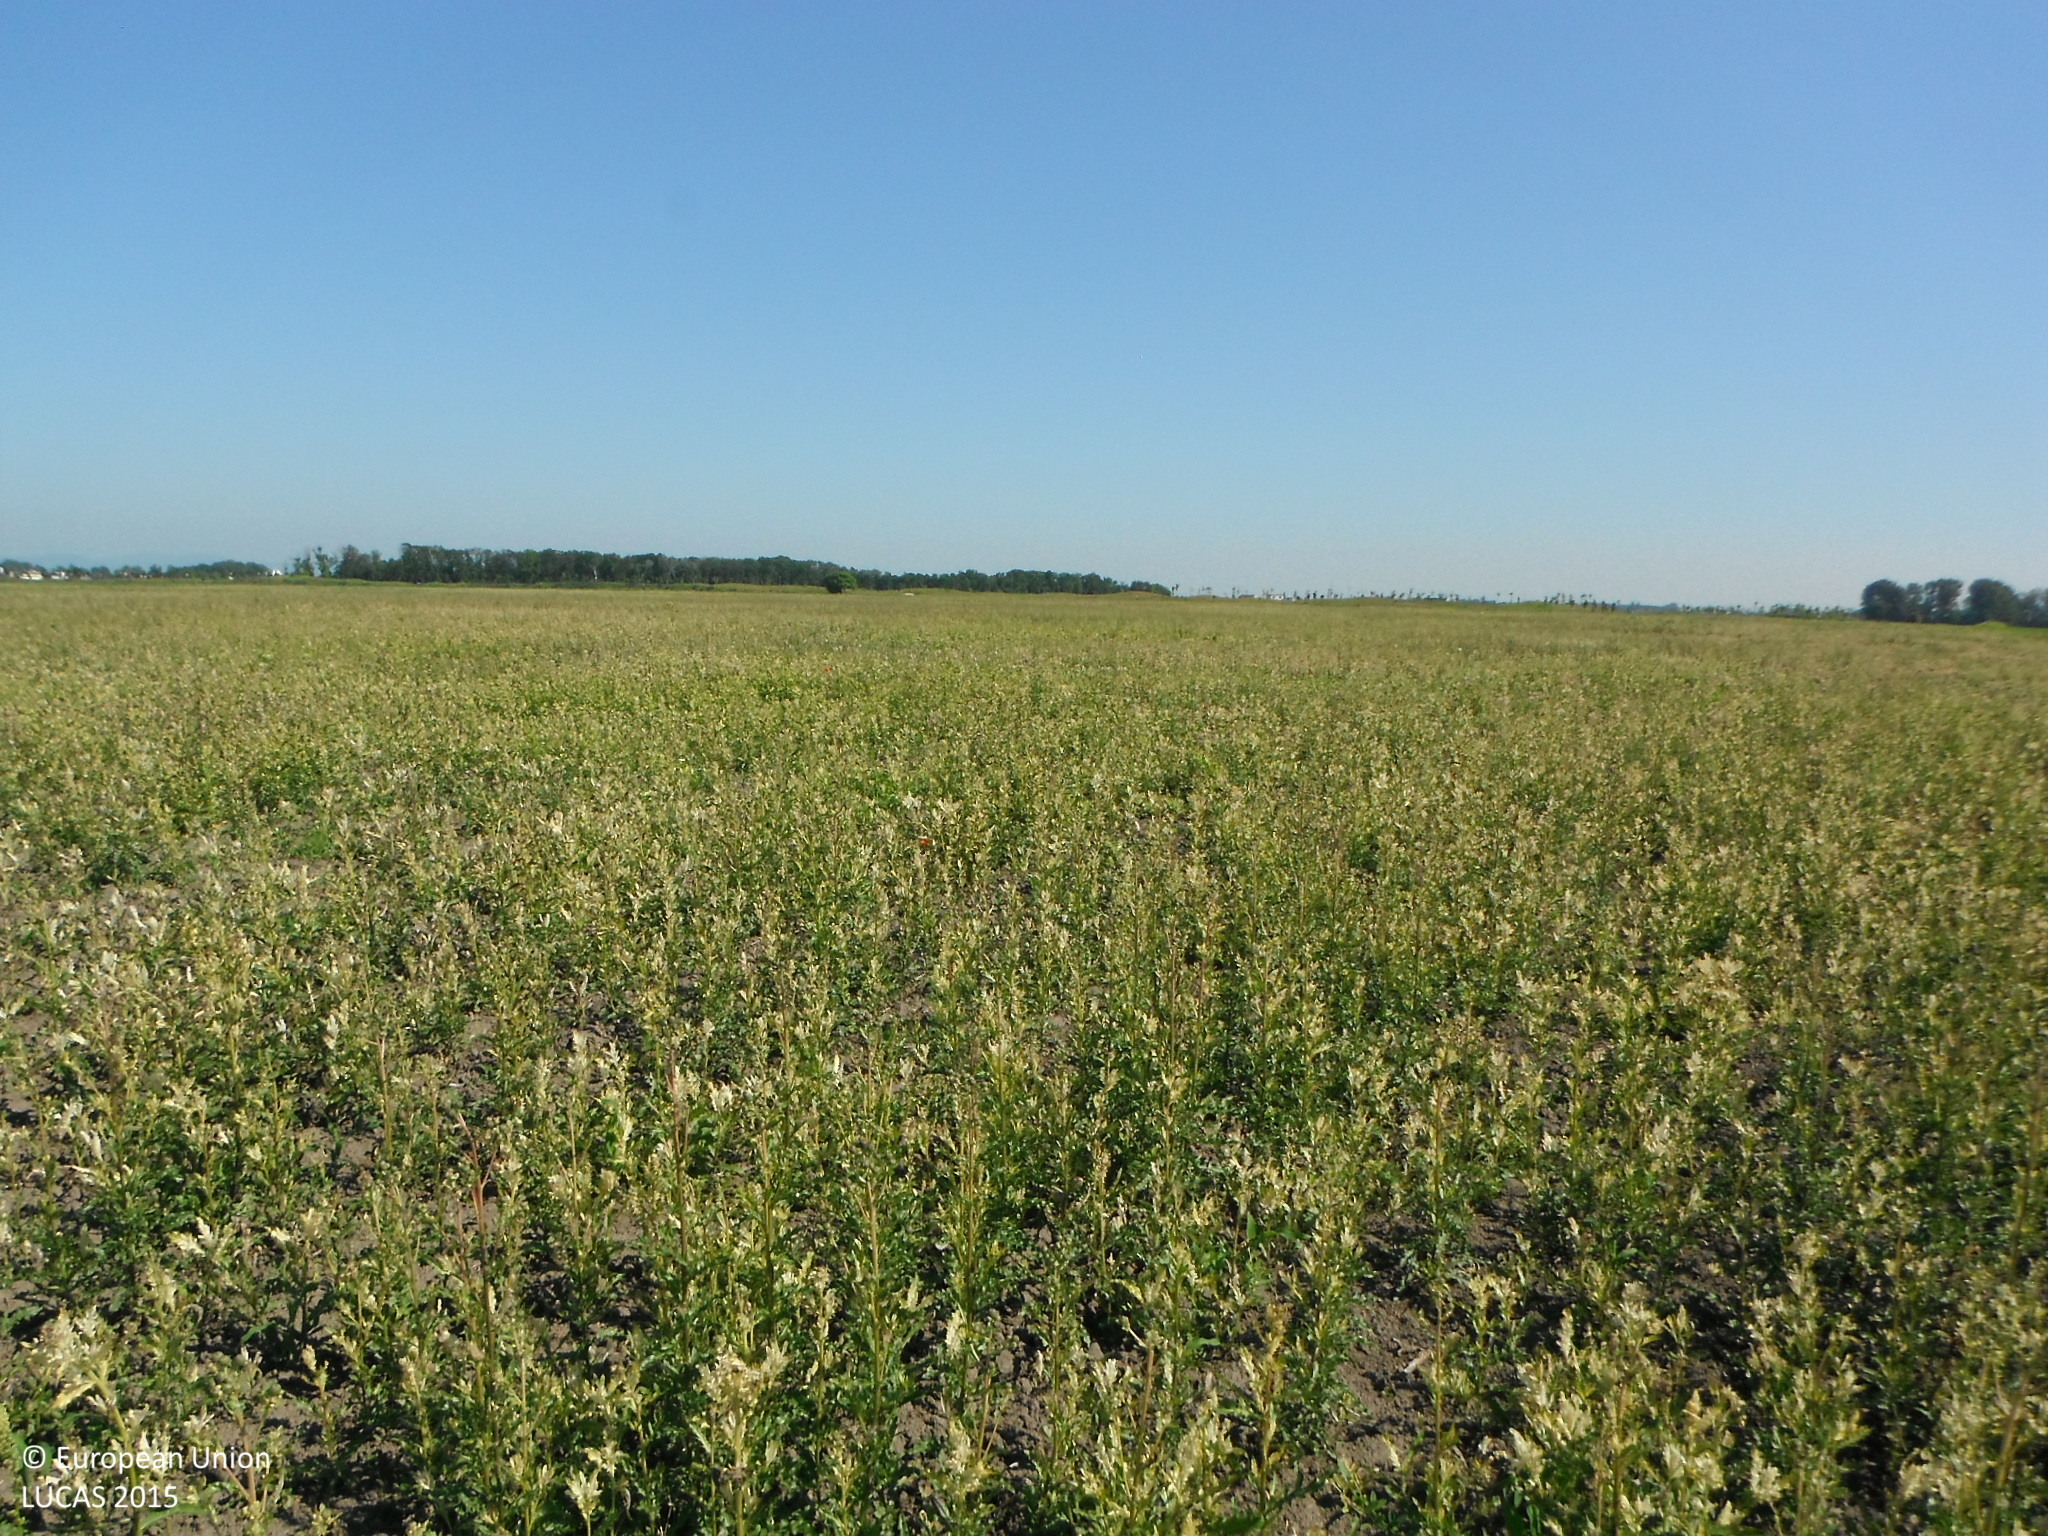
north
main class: Cropland
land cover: Maize
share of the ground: < 10 %
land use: Agriculture (excluding fallow land and kitchen gardens)
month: June
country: SK
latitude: 48.1667
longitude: 17.4992
